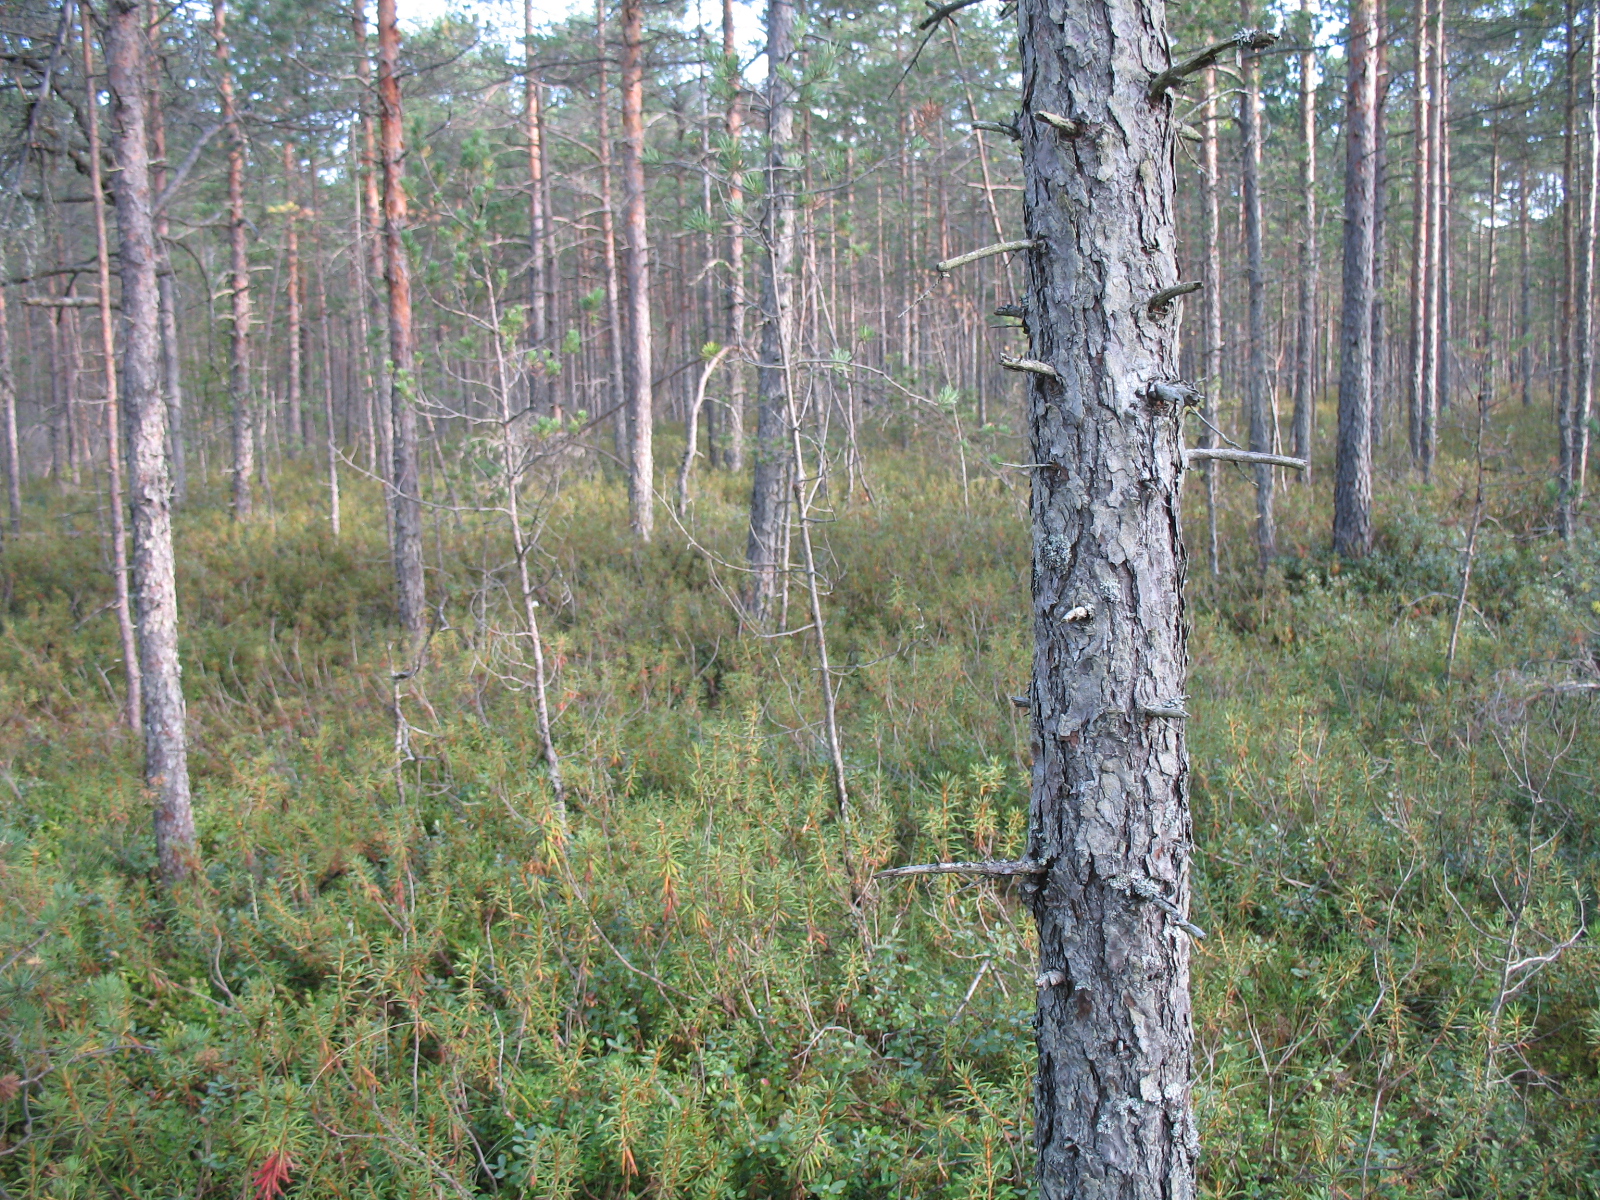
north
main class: Woodland
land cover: Pine dominated coniferous woodland
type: hemiboreal forest and nemoral coniferous forest and mixed broadleaved-coniferous forest
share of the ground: 25 - 50 %
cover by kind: coniferous forest trees 40 %, herbaceous plants 30 %, lichens and mosses 30 %
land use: Forestry
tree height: > 5 m
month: August
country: LV
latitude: 56.2619
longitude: 25.9713
